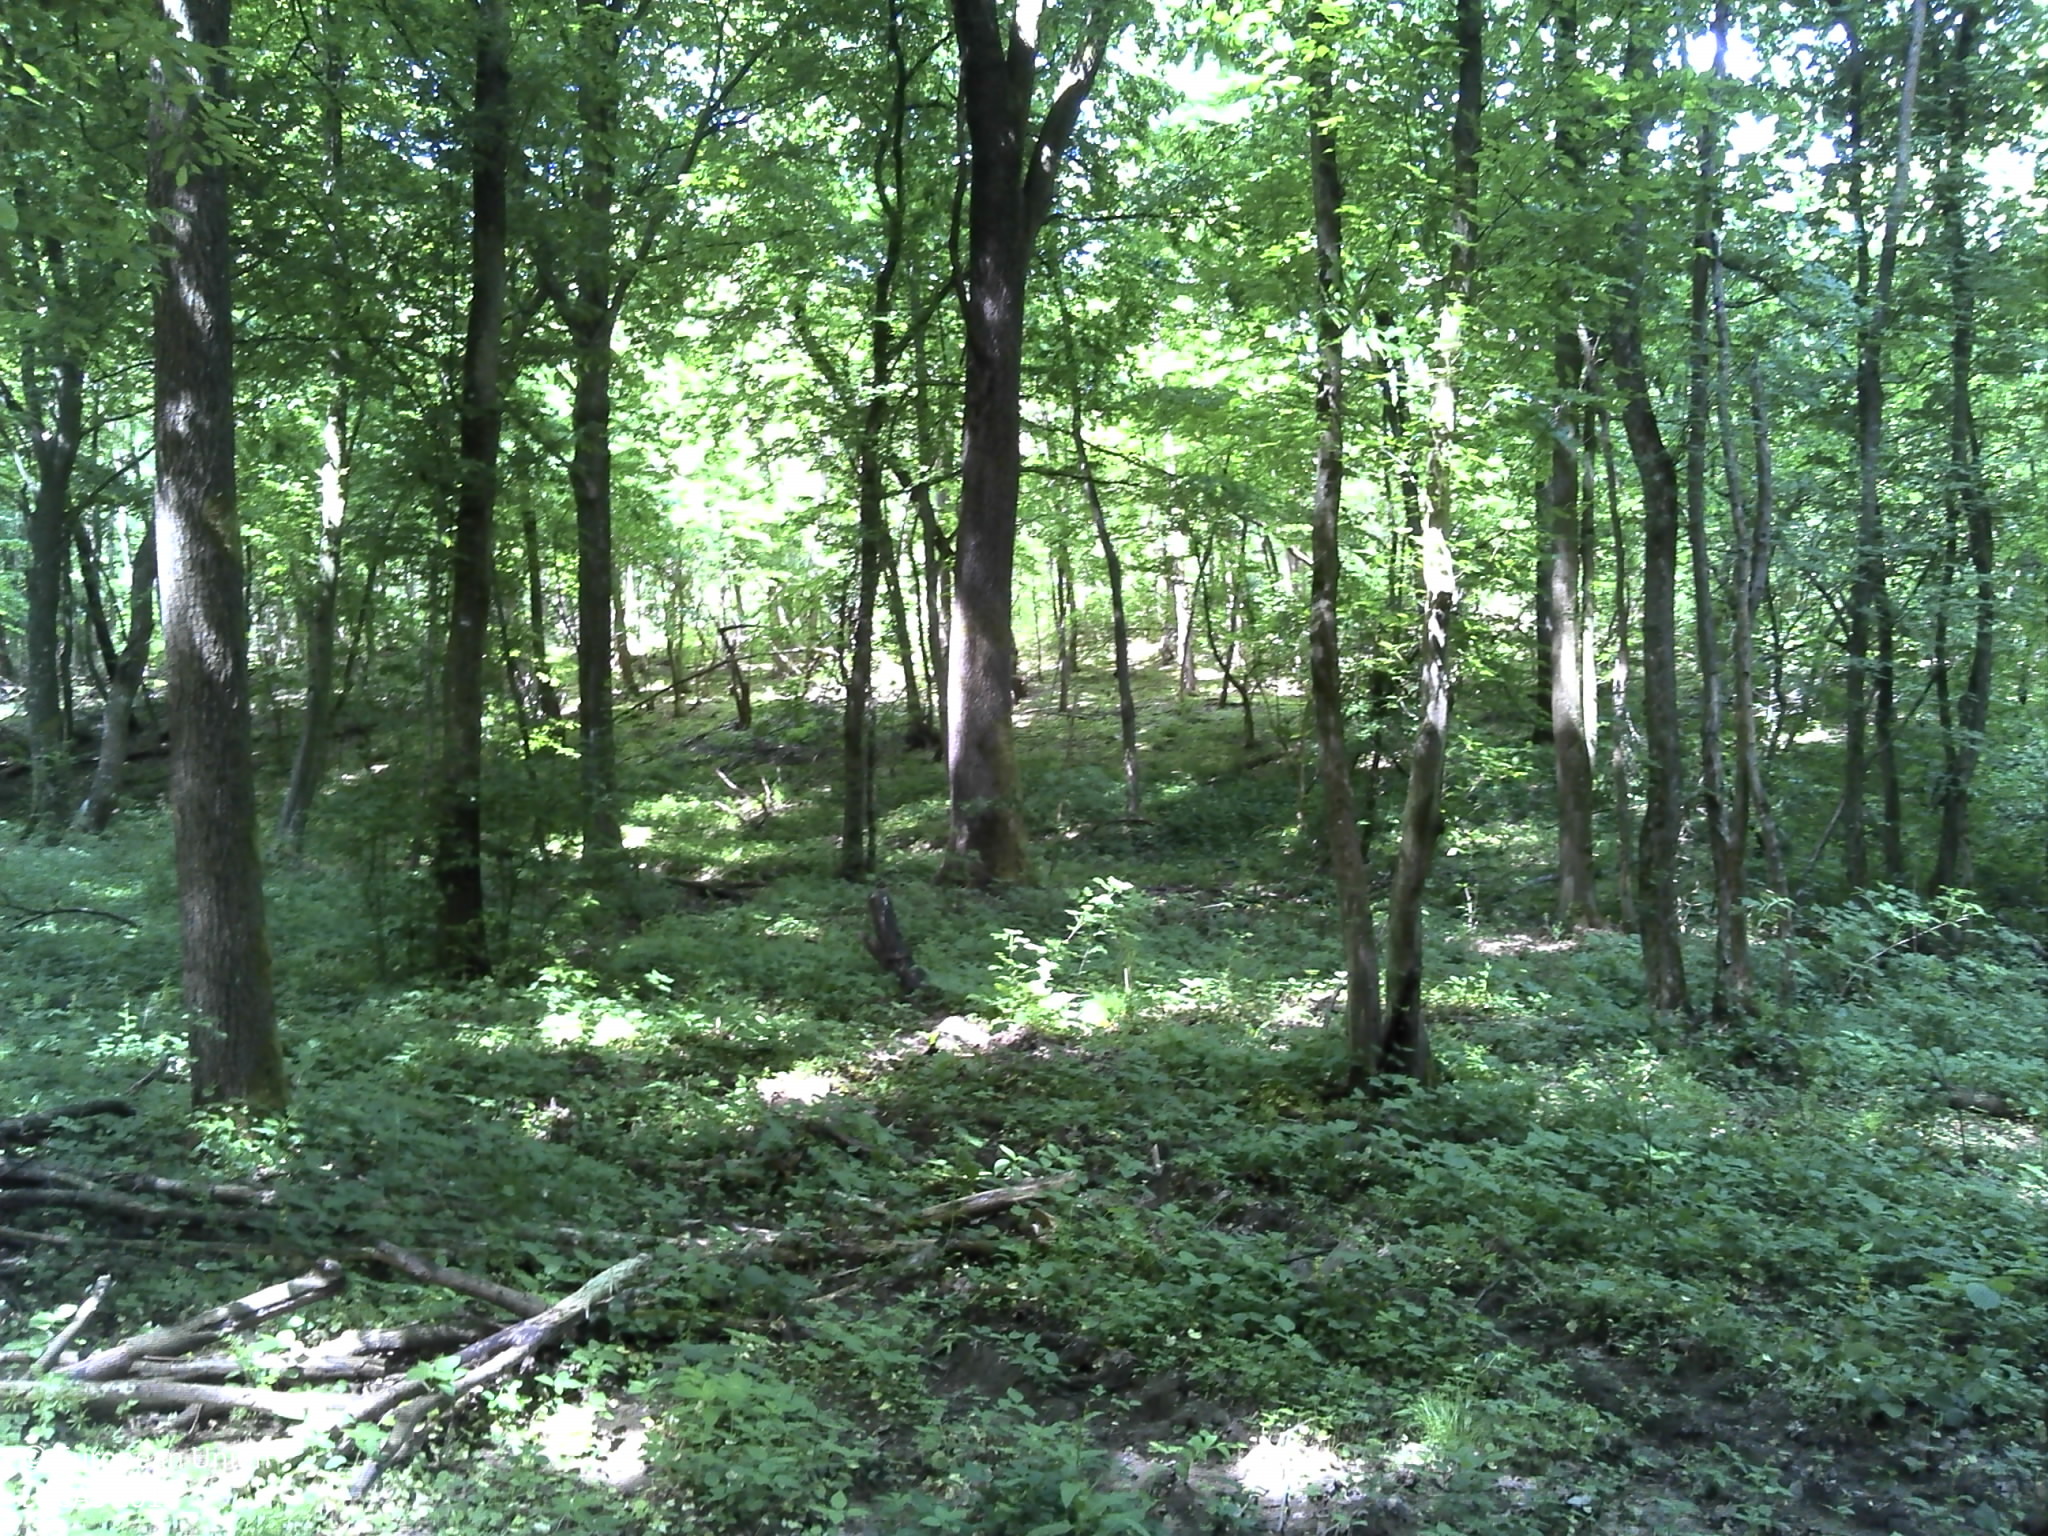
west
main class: Woodland
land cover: Broadleaved woodland
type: acidophilous oak and oak-birch forest
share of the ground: > 75 %
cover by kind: broadleaved forest trees 100 %
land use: Forestry
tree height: > 5 m
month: May
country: HR
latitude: 45.4207
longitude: 18.1962
